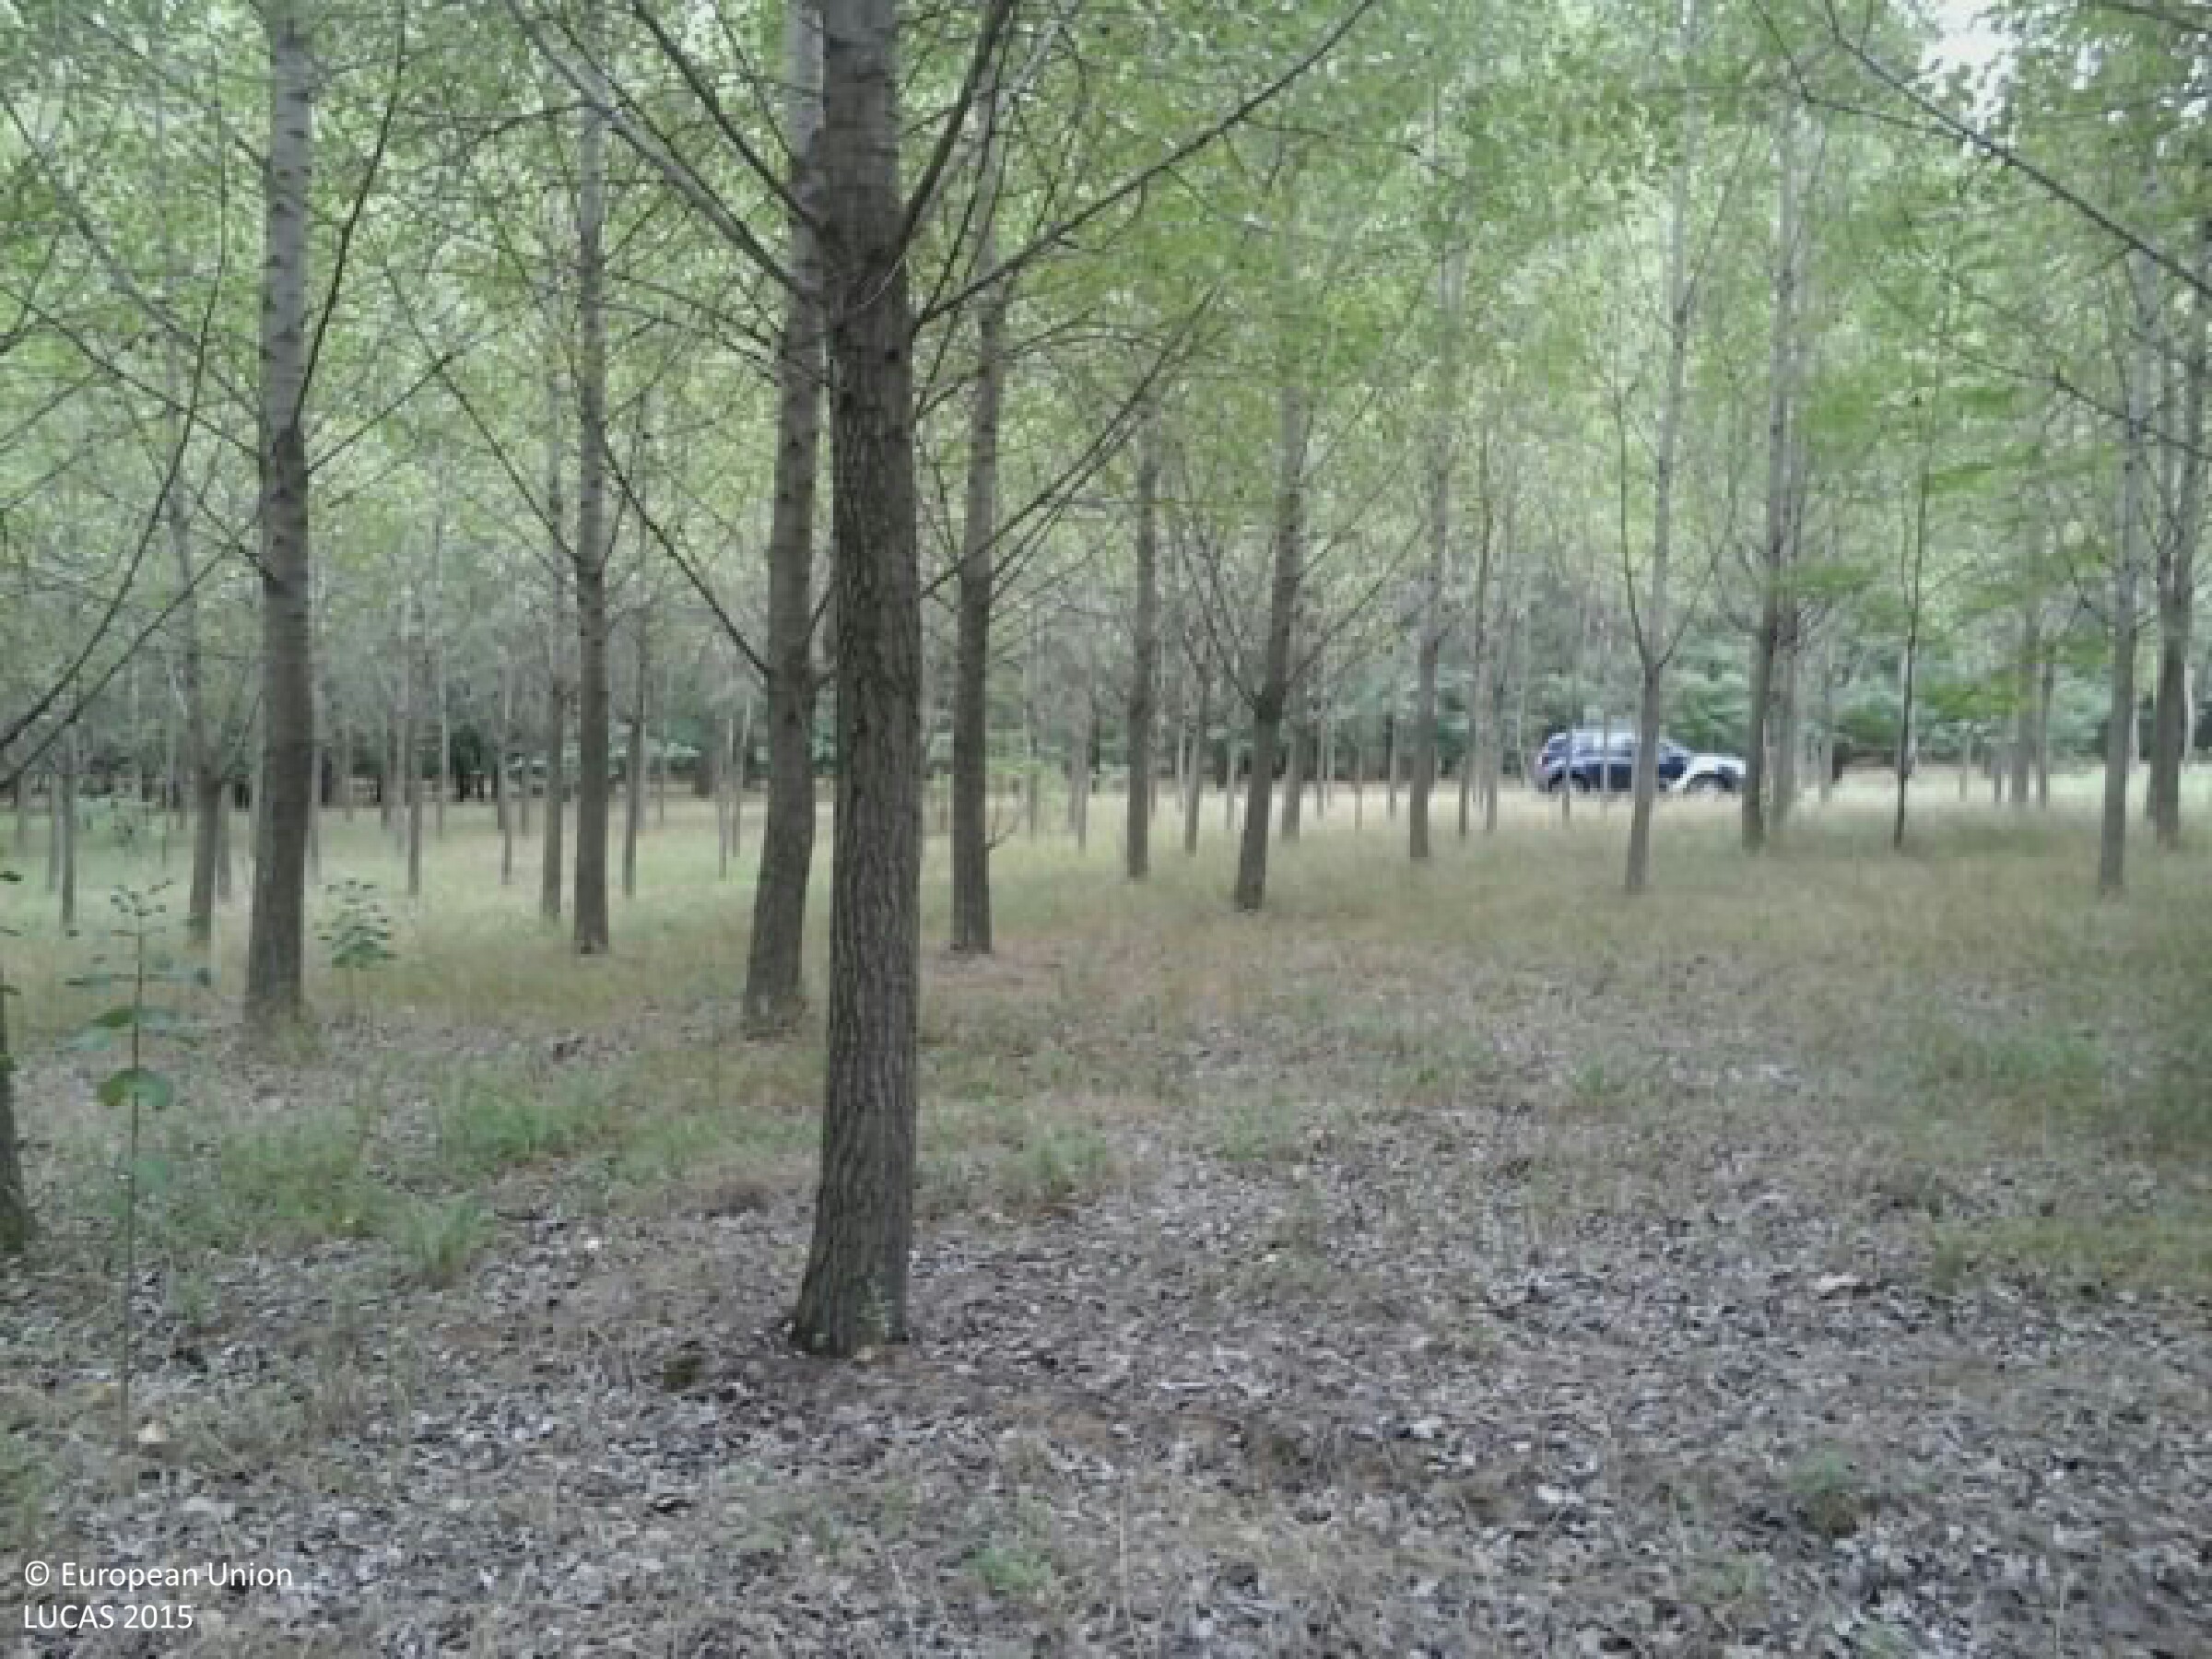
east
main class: Woodland
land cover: Broadleaved woodland
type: mesophytic deciduous forest
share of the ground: > 75 %
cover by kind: broadleaved forest trees 80 %, herbaceous plants 20 %
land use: Forestry
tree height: > 5 m
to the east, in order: Broadleaved woodland; Tracks; Grass margins; Broadleaved woodland; Shrubland with sparse tree cover; Tracks; Shrubland with sparse tree cover; Tracks; Shrubland with sparse tree cover; Electric lines; Shrubland without tree cover
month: July
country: HU
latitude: 47.1257
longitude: 19.6840
